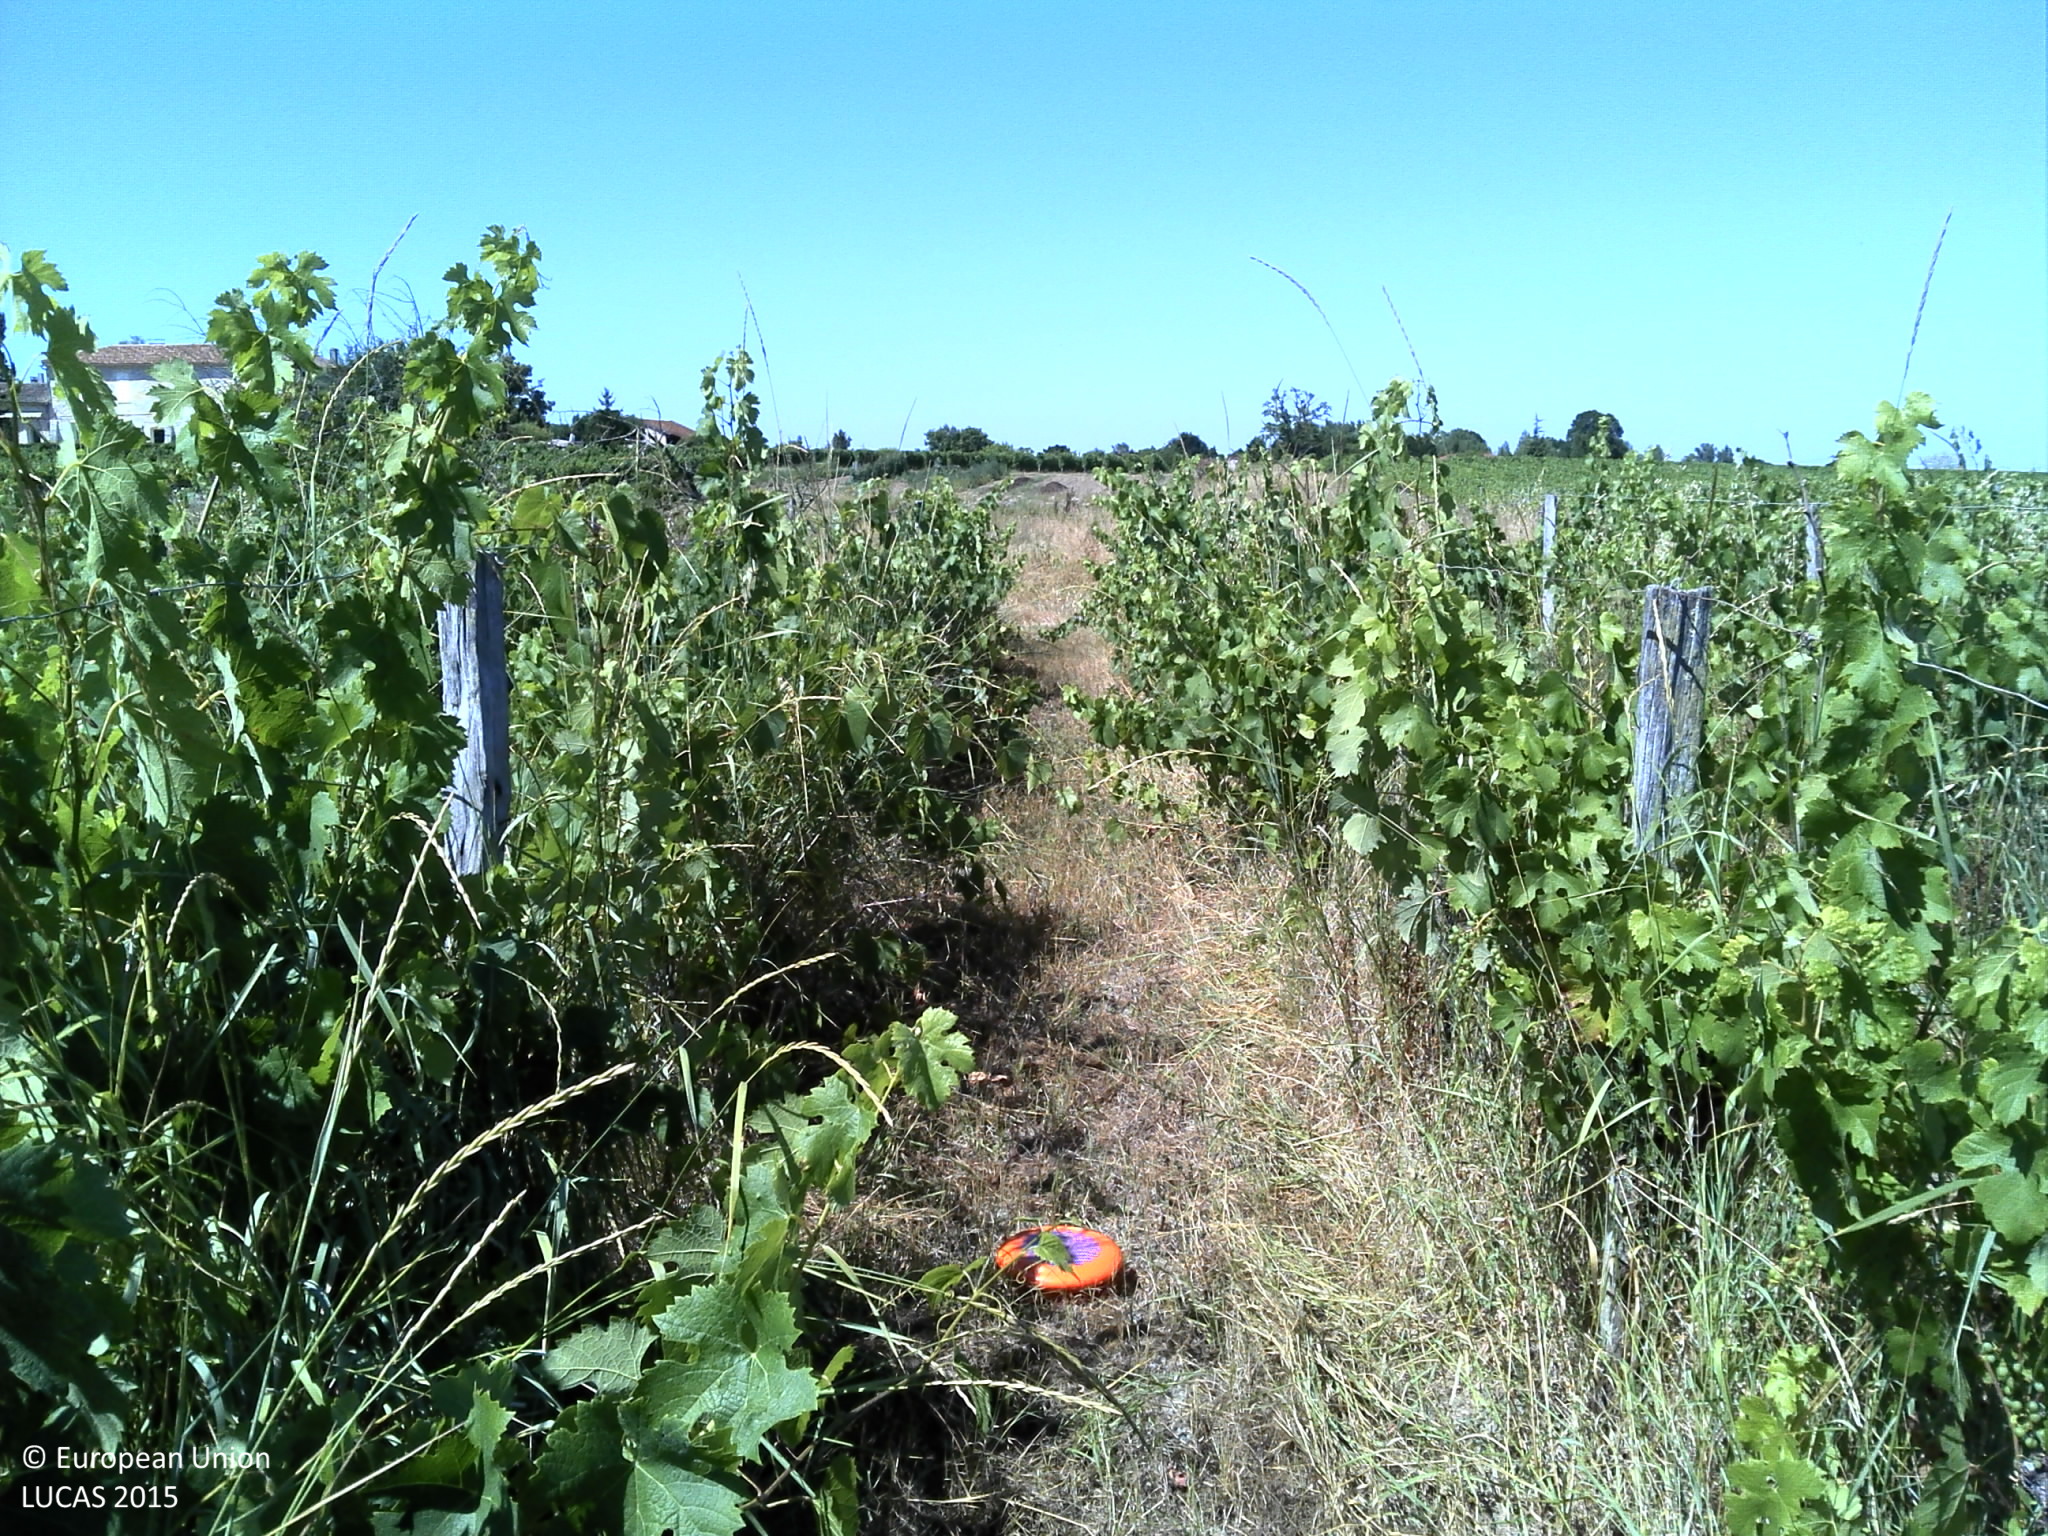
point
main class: Cropland
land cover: Vineyards
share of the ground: 10 - 25 %
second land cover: Grassland without tree/shrub cover
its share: > 75 %
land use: Agriculture (excluding fallow land and kitchen gardens)
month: July
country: FR
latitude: 44.8947
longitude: -0.4390
